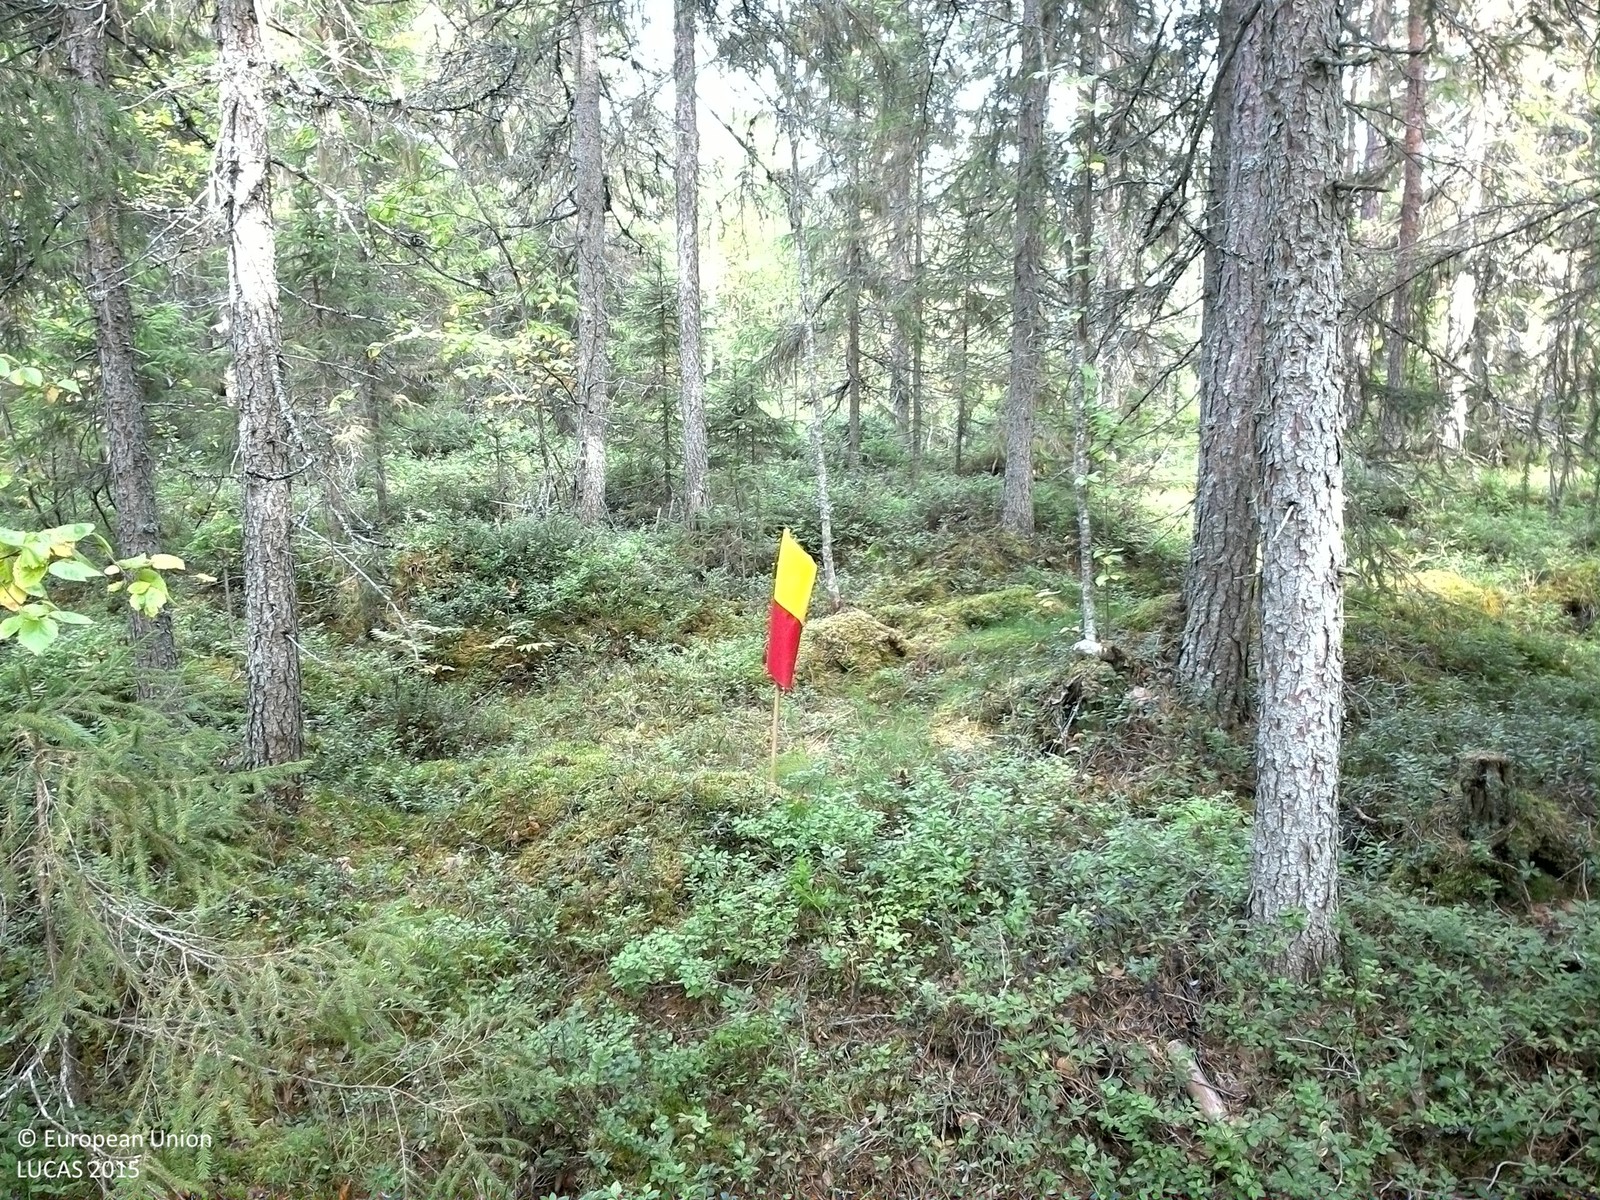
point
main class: Woodland
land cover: Spruce dominated coniferous woodland
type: boreal forest
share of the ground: > 75 %
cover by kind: coniferous forest trees 55 %, shrubs 25 %, broadleaved forest trees 10 %, lichens and mosses 10 %
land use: Forestry
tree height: > 5 m
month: September
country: SE
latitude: 64.0277
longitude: 16.5403
